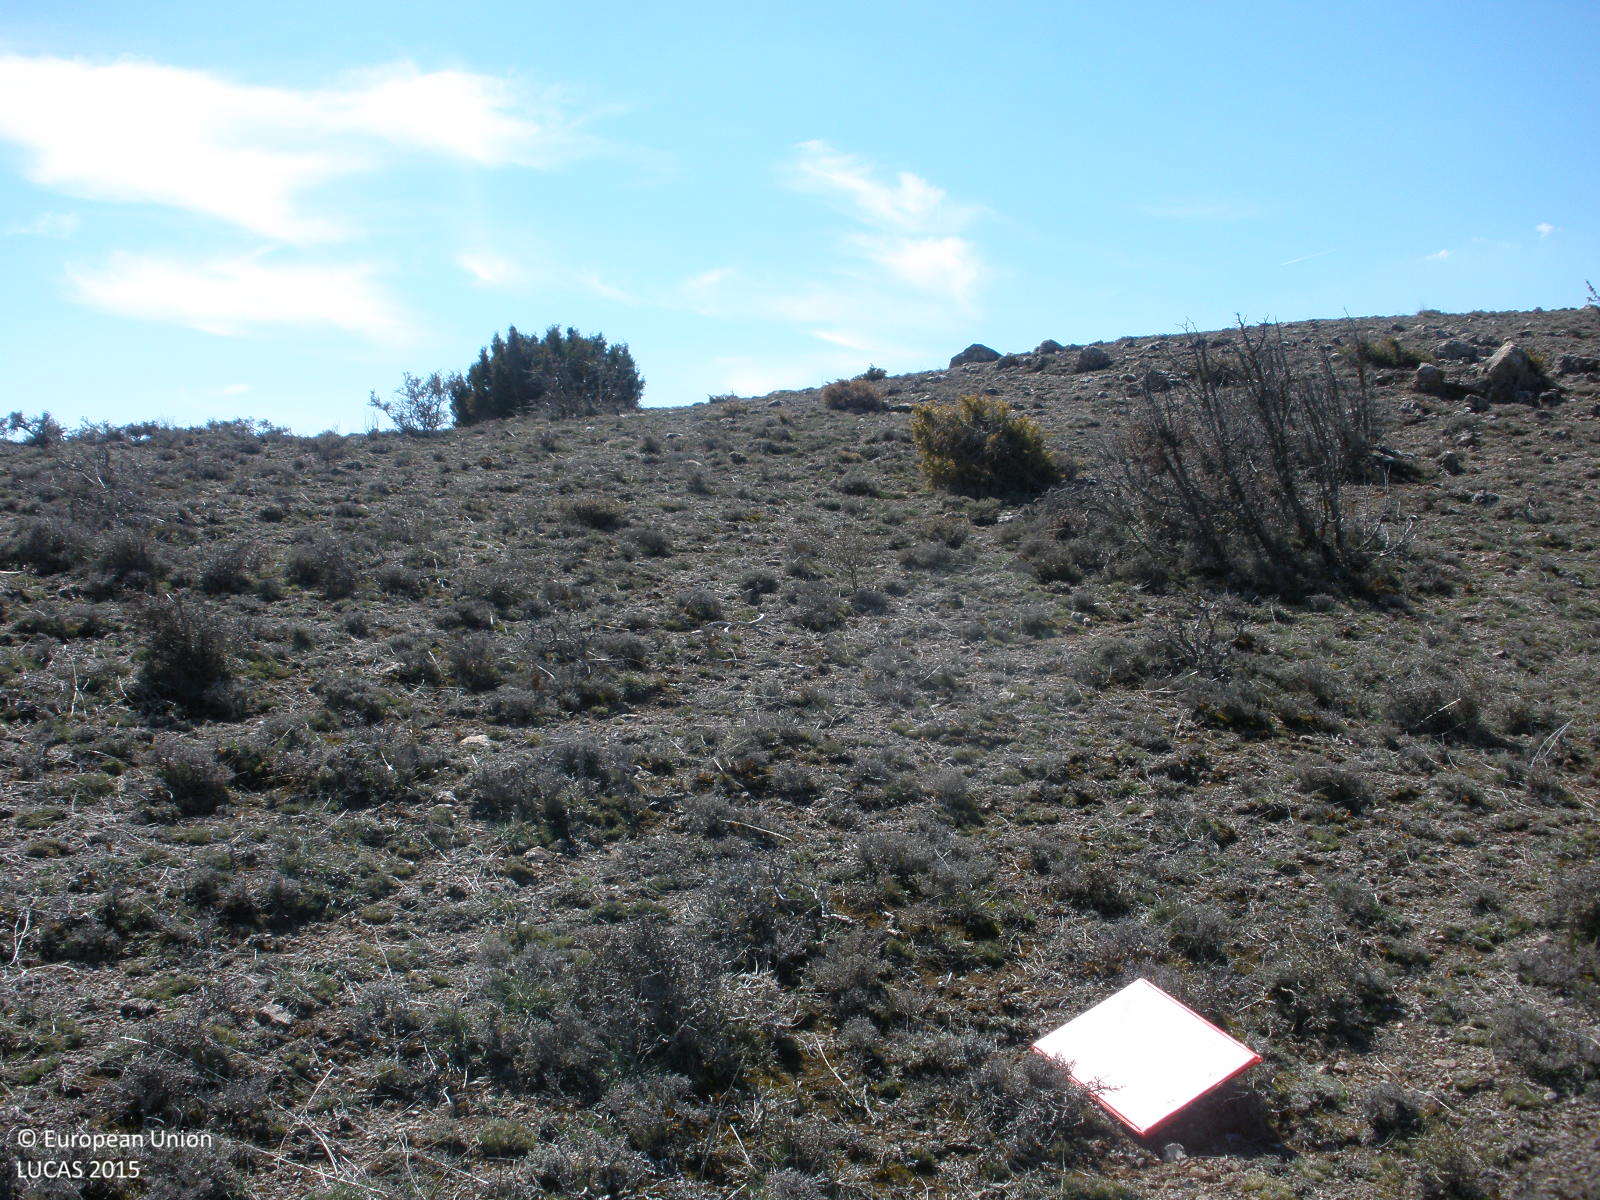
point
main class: Shrubland
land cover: Shrubland without tree cover
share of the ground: 50 - 75 %
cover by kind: shrubs 70 %, consolidated bare surface 30 %
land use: Semi-natural and natural areas not in use
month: April
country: ES
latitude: 40.9818
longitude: -1.1300
